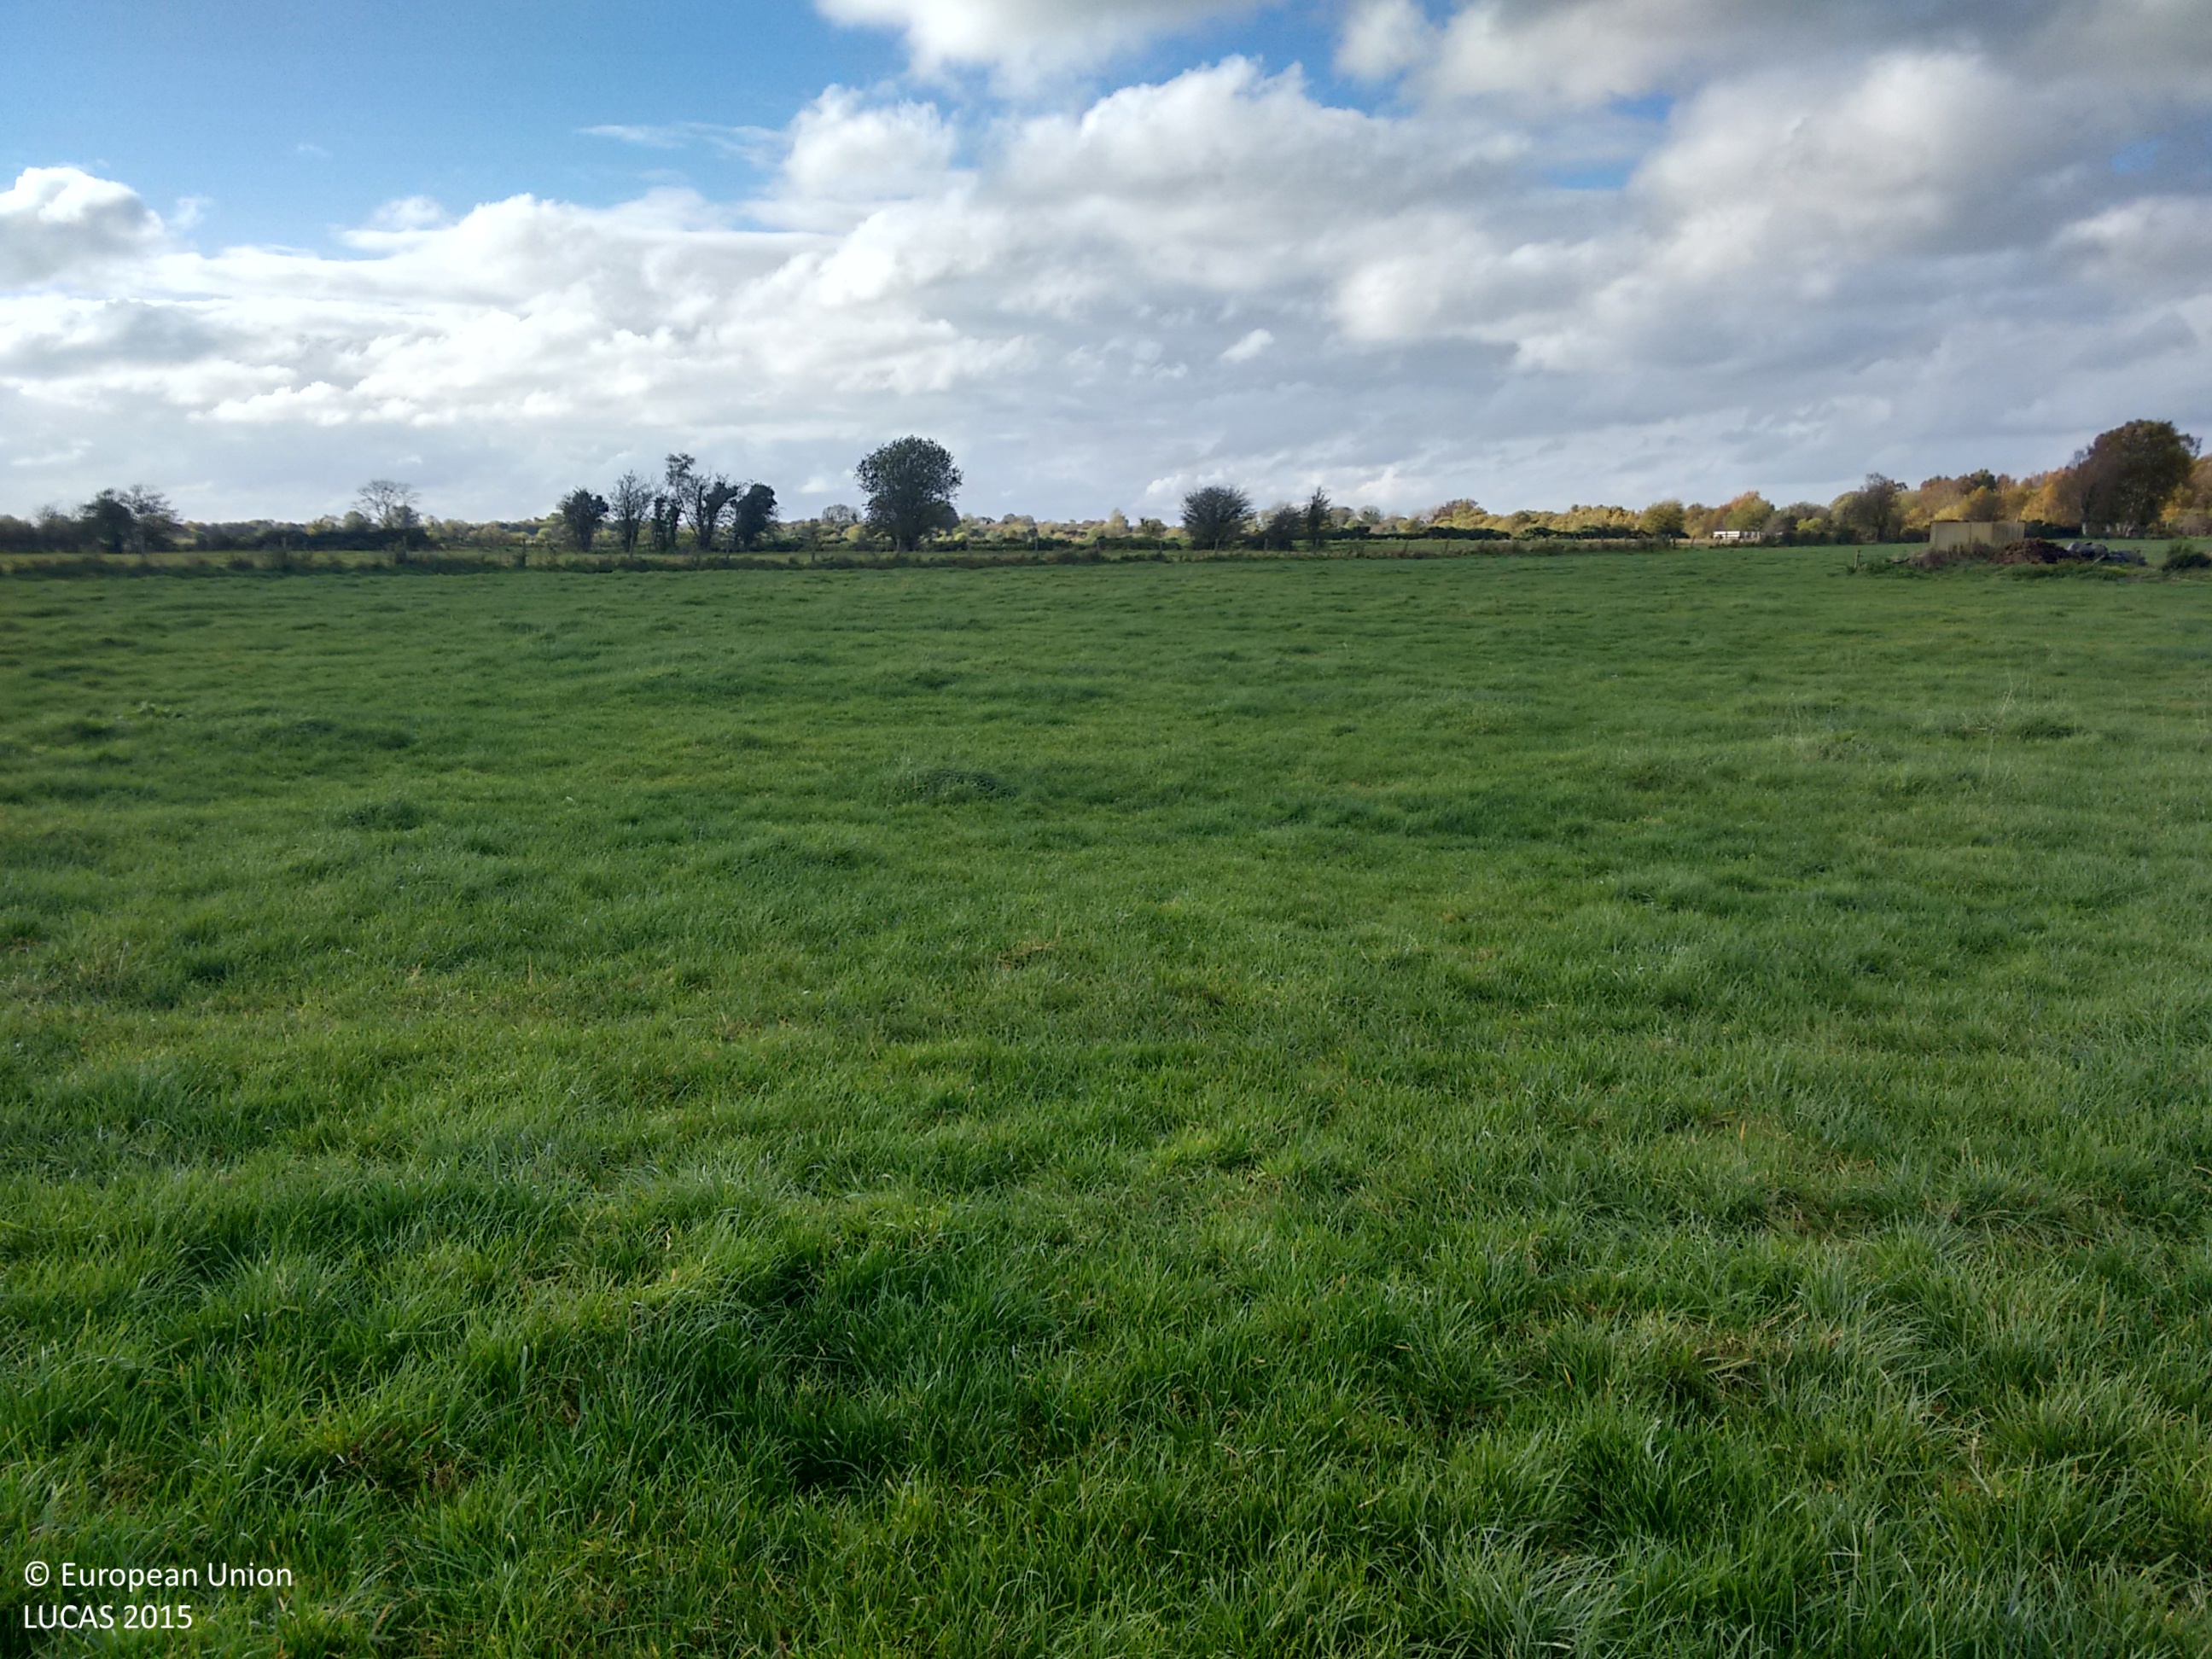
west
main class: Grassland
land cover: Grassland without tree/shrub cover
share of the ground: > 75 %
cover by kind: herbaceous plants 100 %
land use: Agriculture (excluding fallow land and kitchen gardens)
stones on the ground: < 10 %
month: October
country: IE
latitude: 53.2725
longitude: -7.7564
